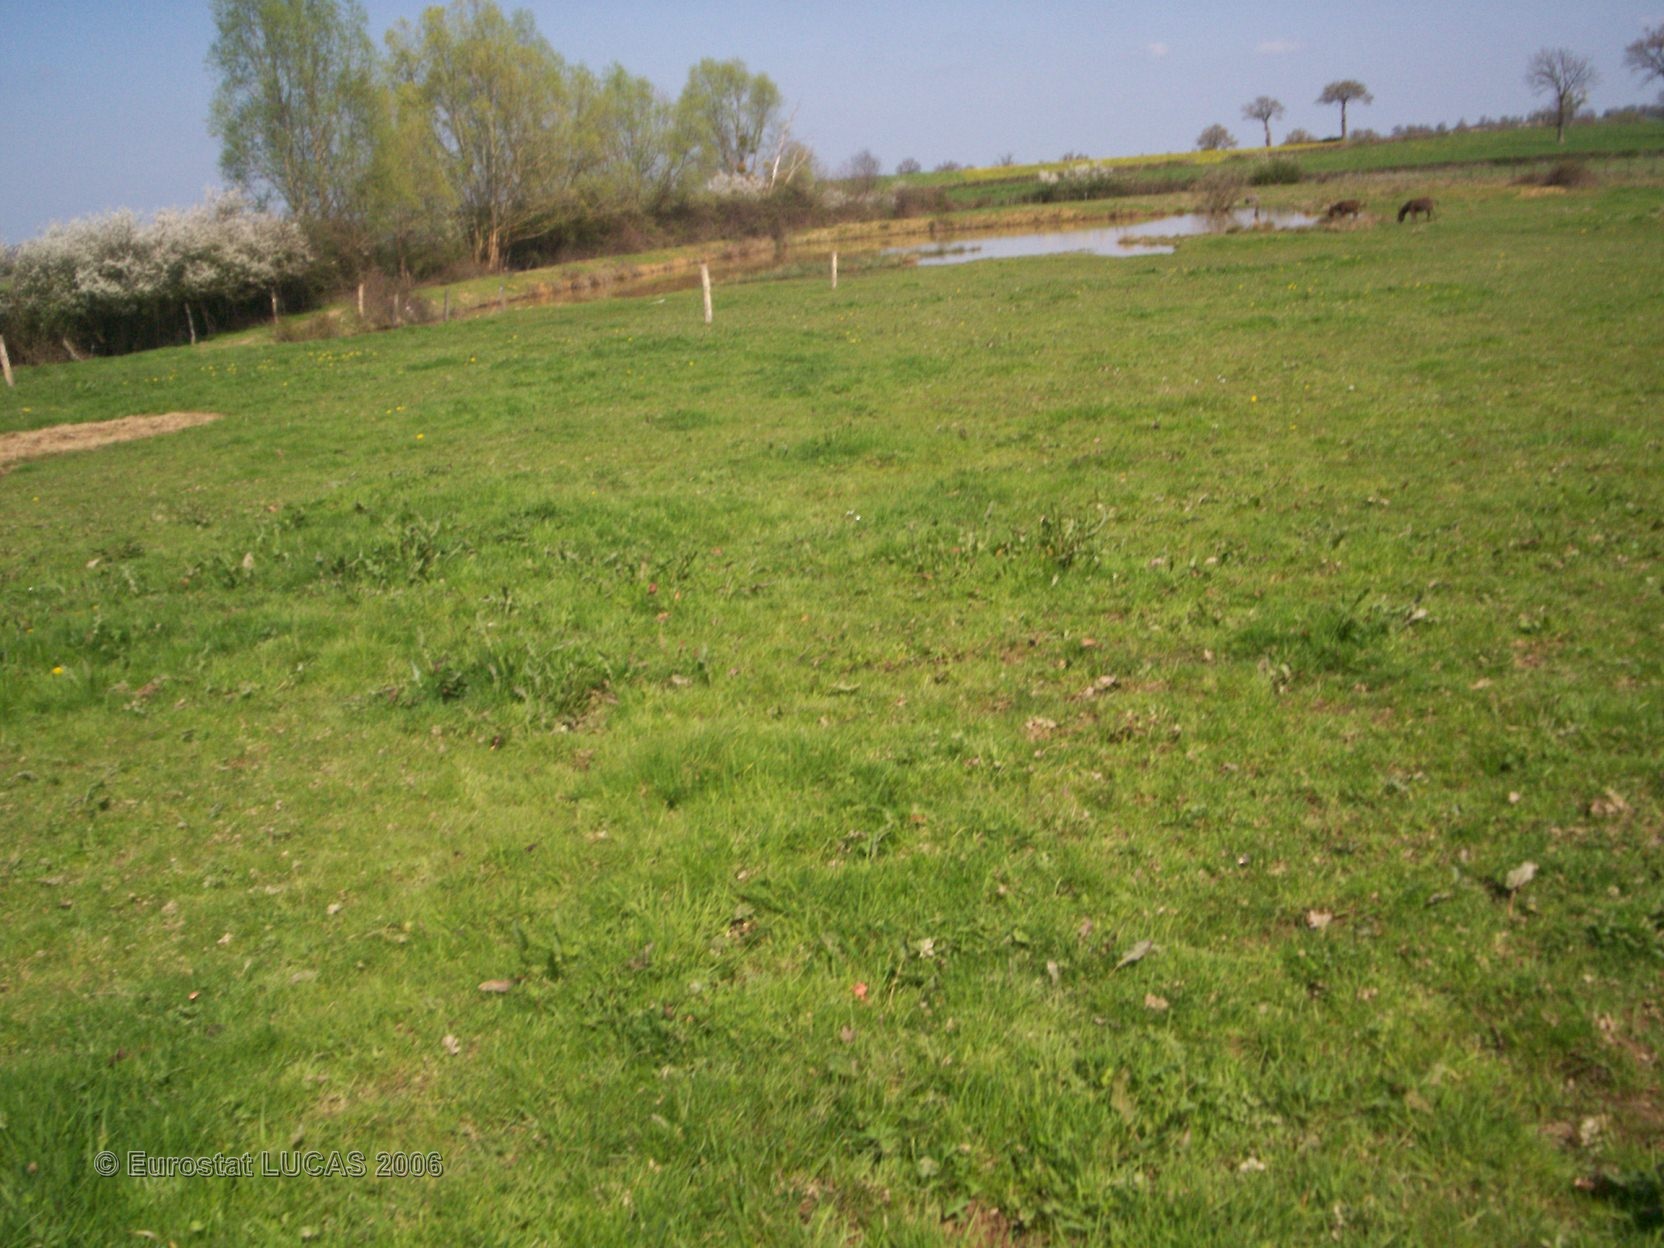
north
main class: Grassland
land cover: Grassland without tree/shrub cover
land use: Agriculture (excluding fallow land and kitchen gardens)
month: April
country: FR
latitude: 46.5960
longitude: 3.0658
